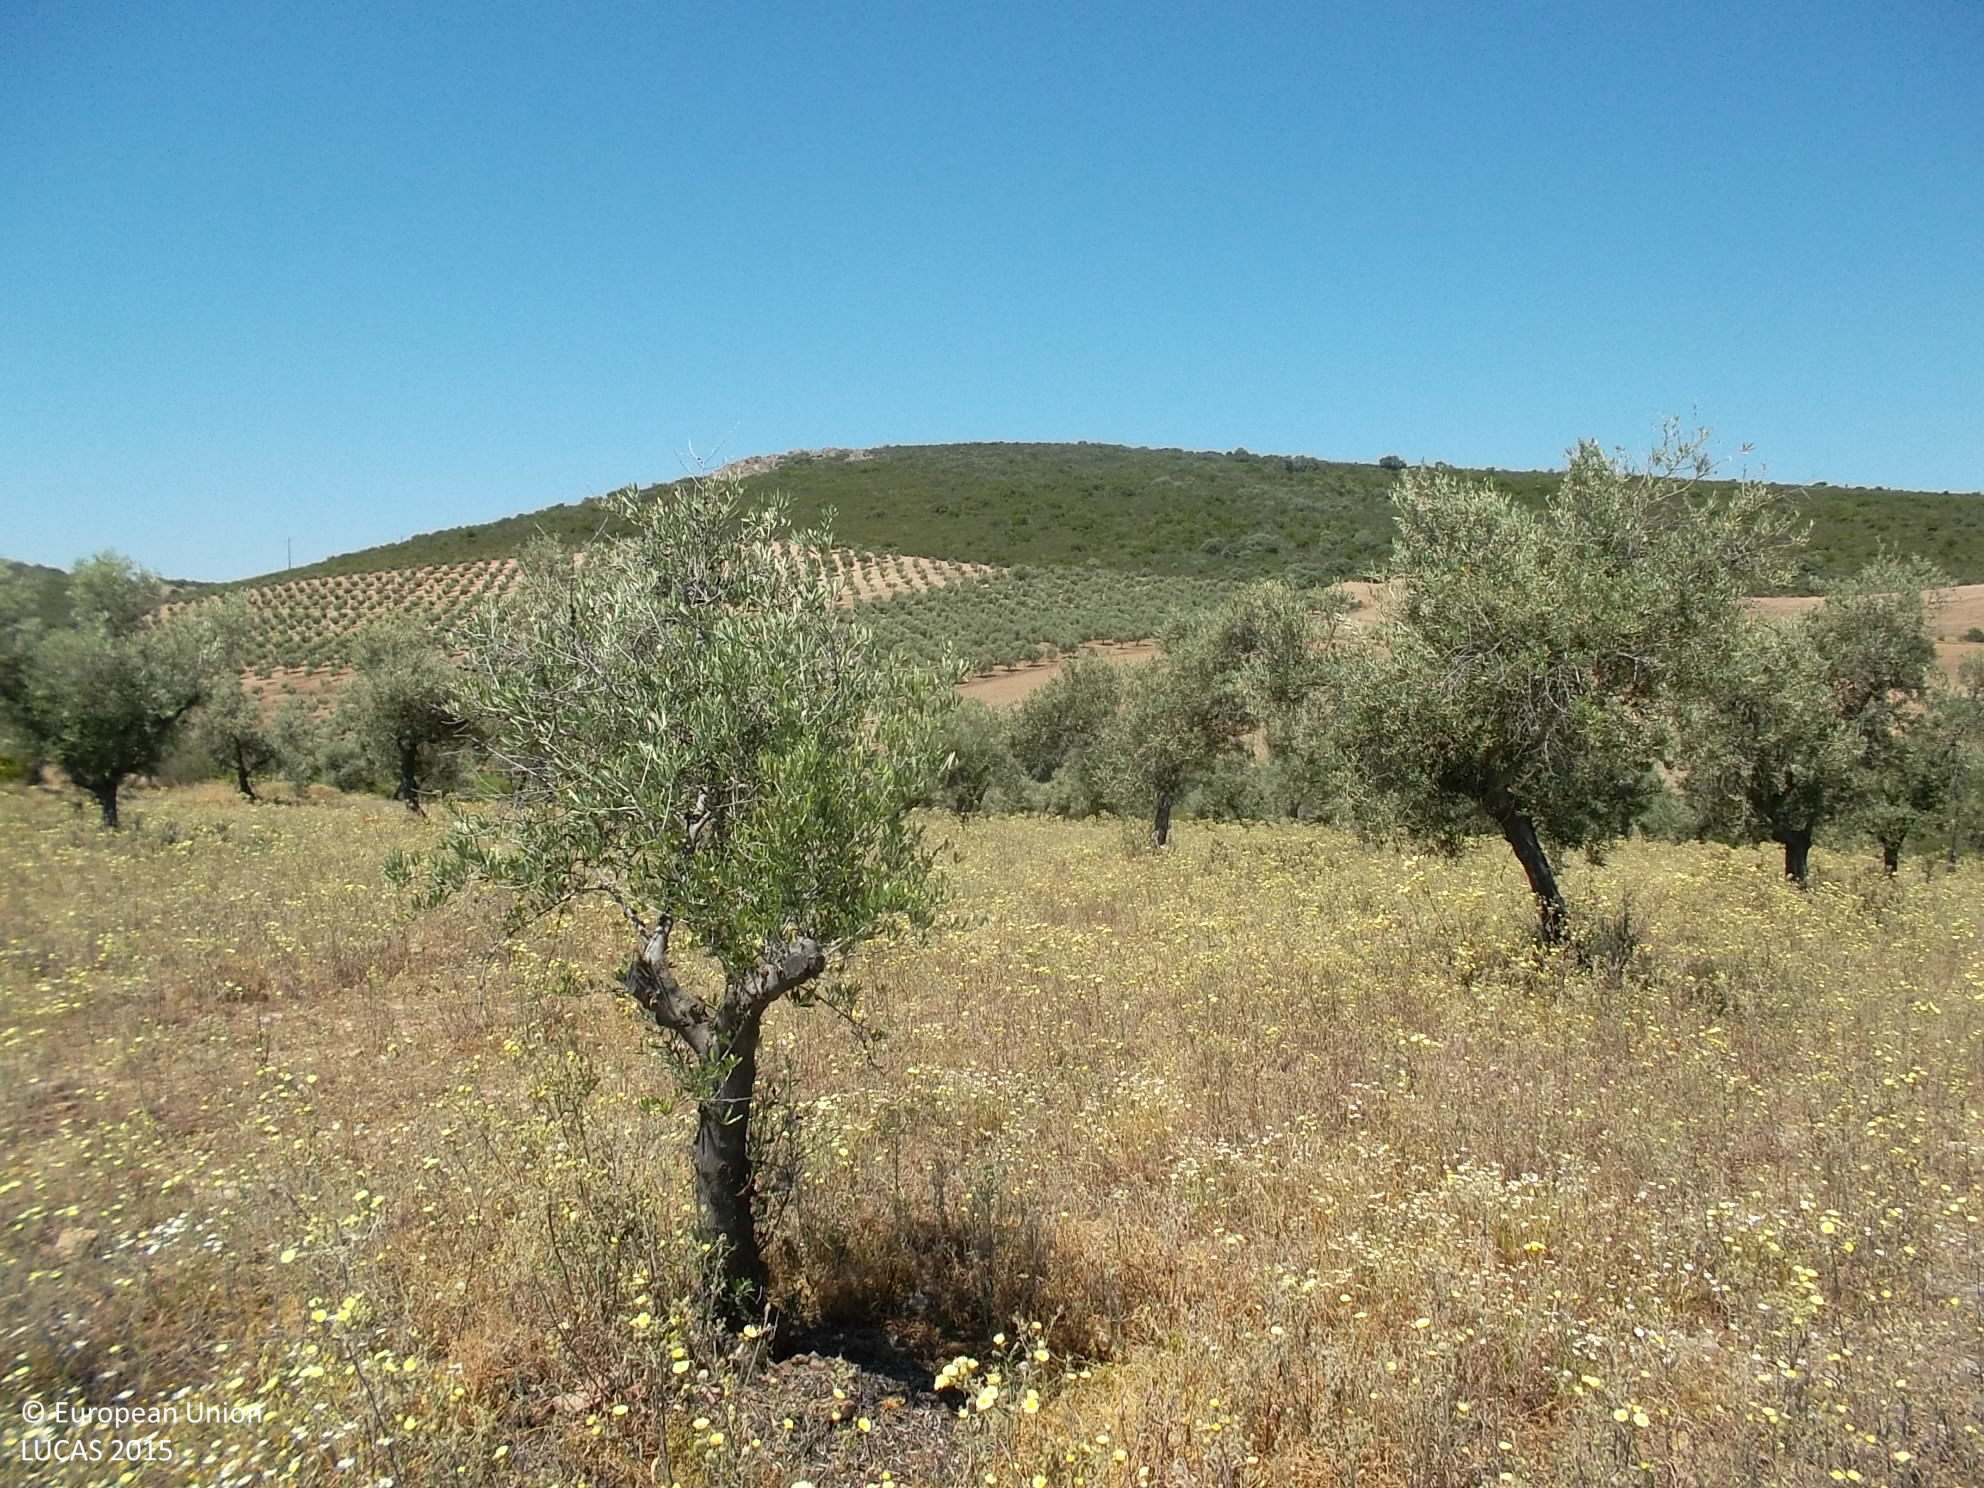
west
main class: Cropland
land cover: Olive groves
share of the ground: 25 - 50 %
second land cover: Spontaneously vegetated surfaces
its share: 50 - 75 %
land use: Agriculture (excluding fallow land and kitchen gardens)
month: May
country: ES
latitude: 38.7910
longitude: -4.4267
